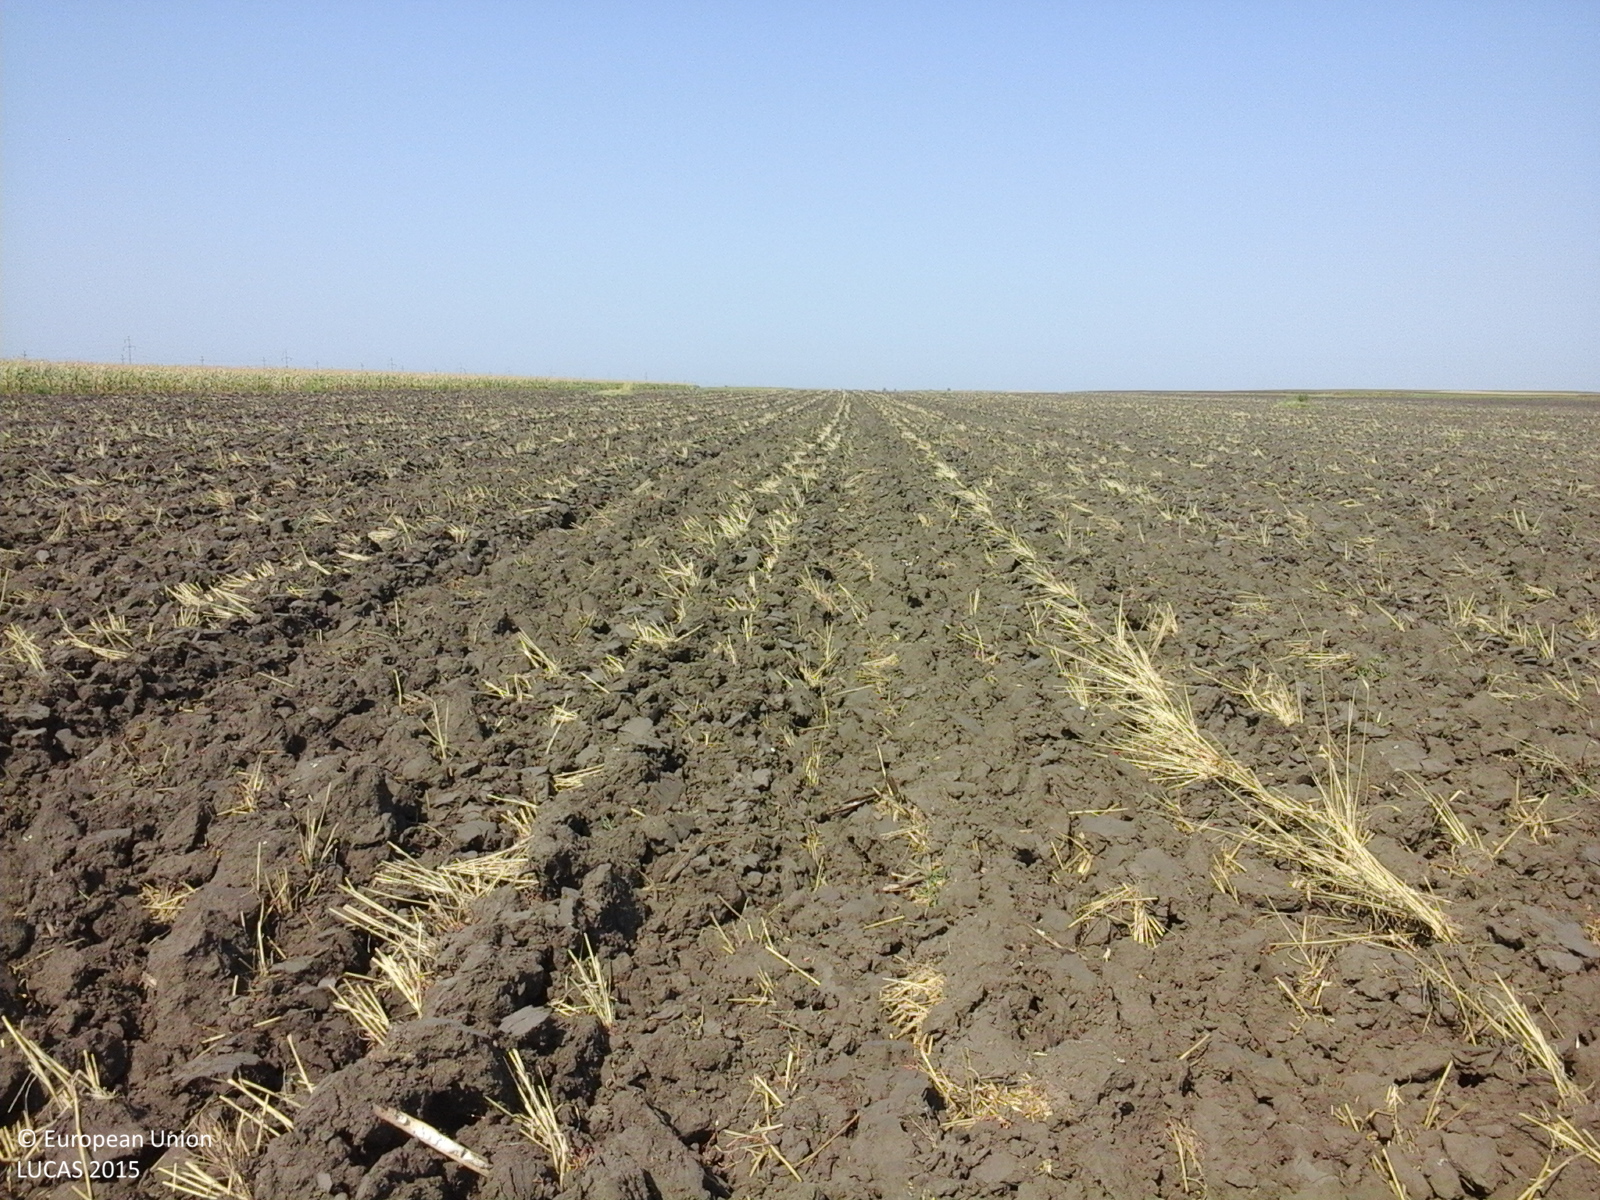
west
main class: Cropland
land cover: Common wheat
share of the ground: < 10 %
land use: Agriculture (excluding fallow land and kitchen gardens)
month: August
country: RO
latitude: 44.1169
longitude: 23.2539
